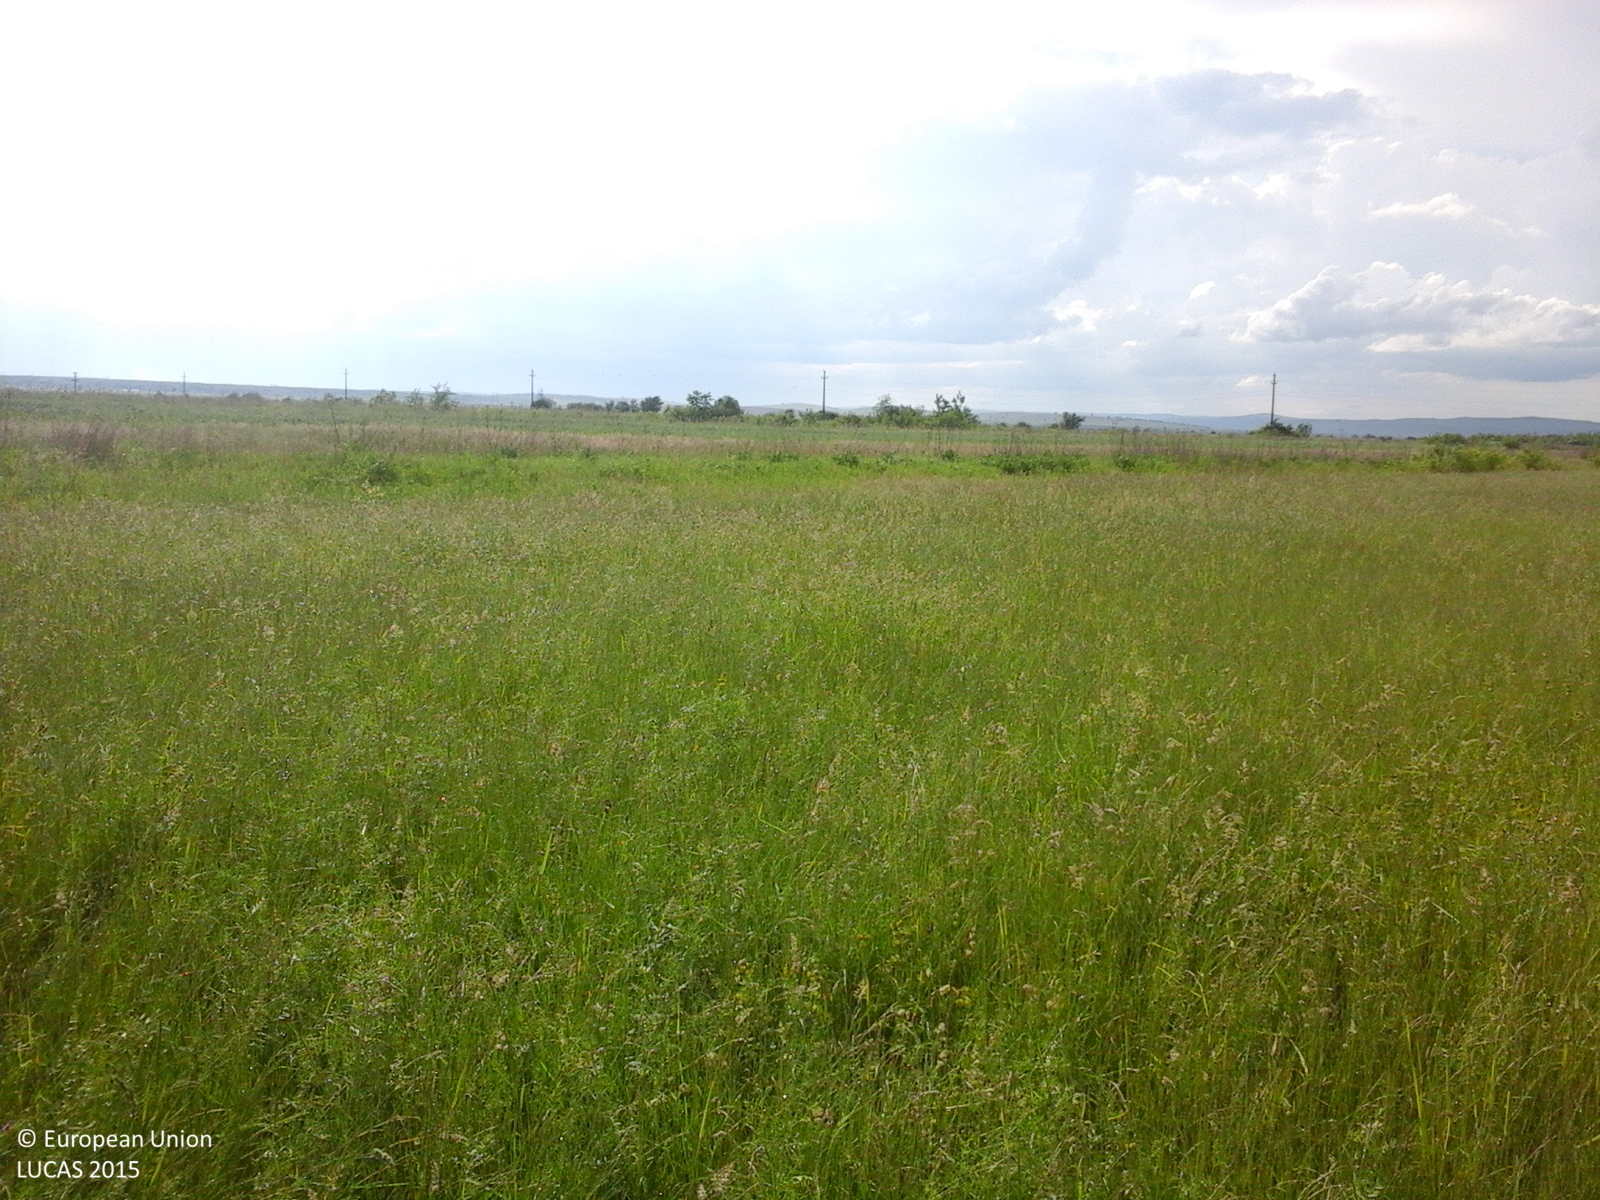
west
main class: Grassland
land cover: Spontaneously vegetated surfaces
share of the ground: > 75 %
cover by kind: herbaceous plants 100 %
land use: Semi-natural and natural areas not in use
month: May
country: RO
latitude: 45.7726
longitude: 25.1805
